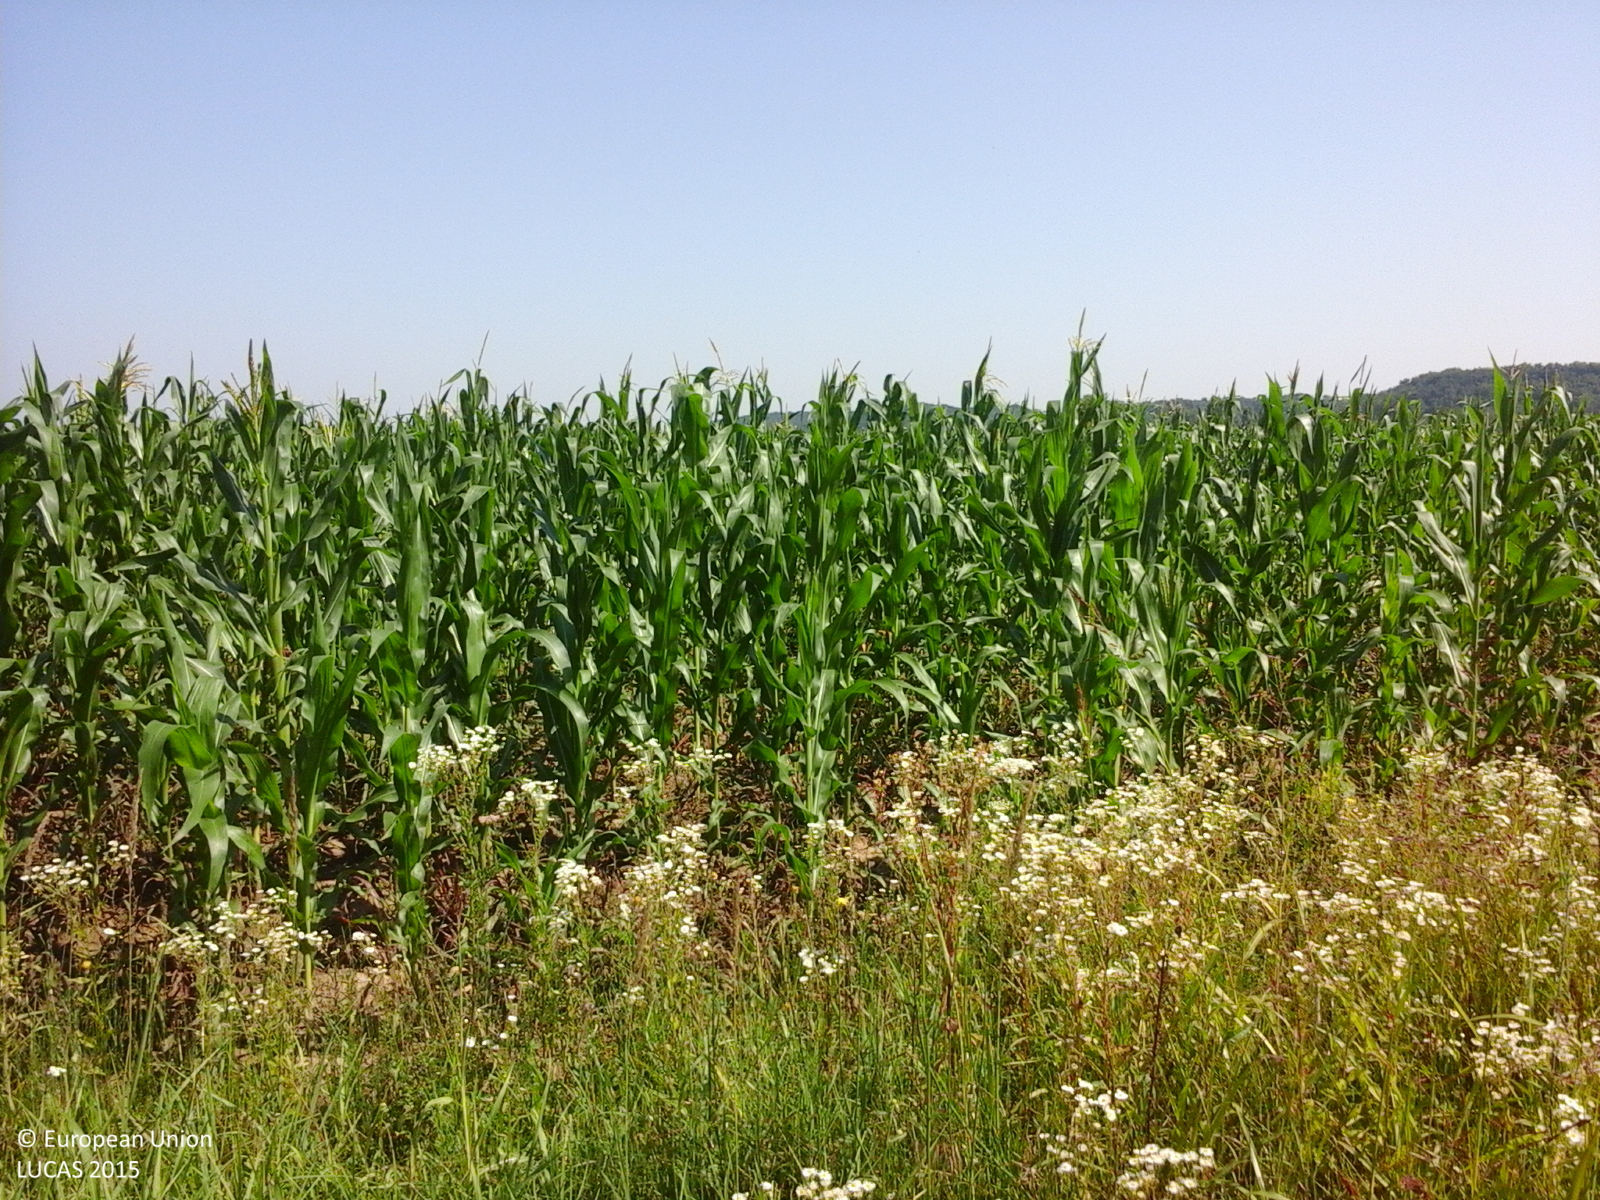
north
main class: Grassland
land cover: Spontaneously vegetated surfaces
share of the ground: > 75 %
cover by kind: herbaceous plants 100 %
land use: Agriculture (excluding fallow land and kitchen gardens)
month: July
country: RO
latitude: 44.6699
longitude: 24.3098
